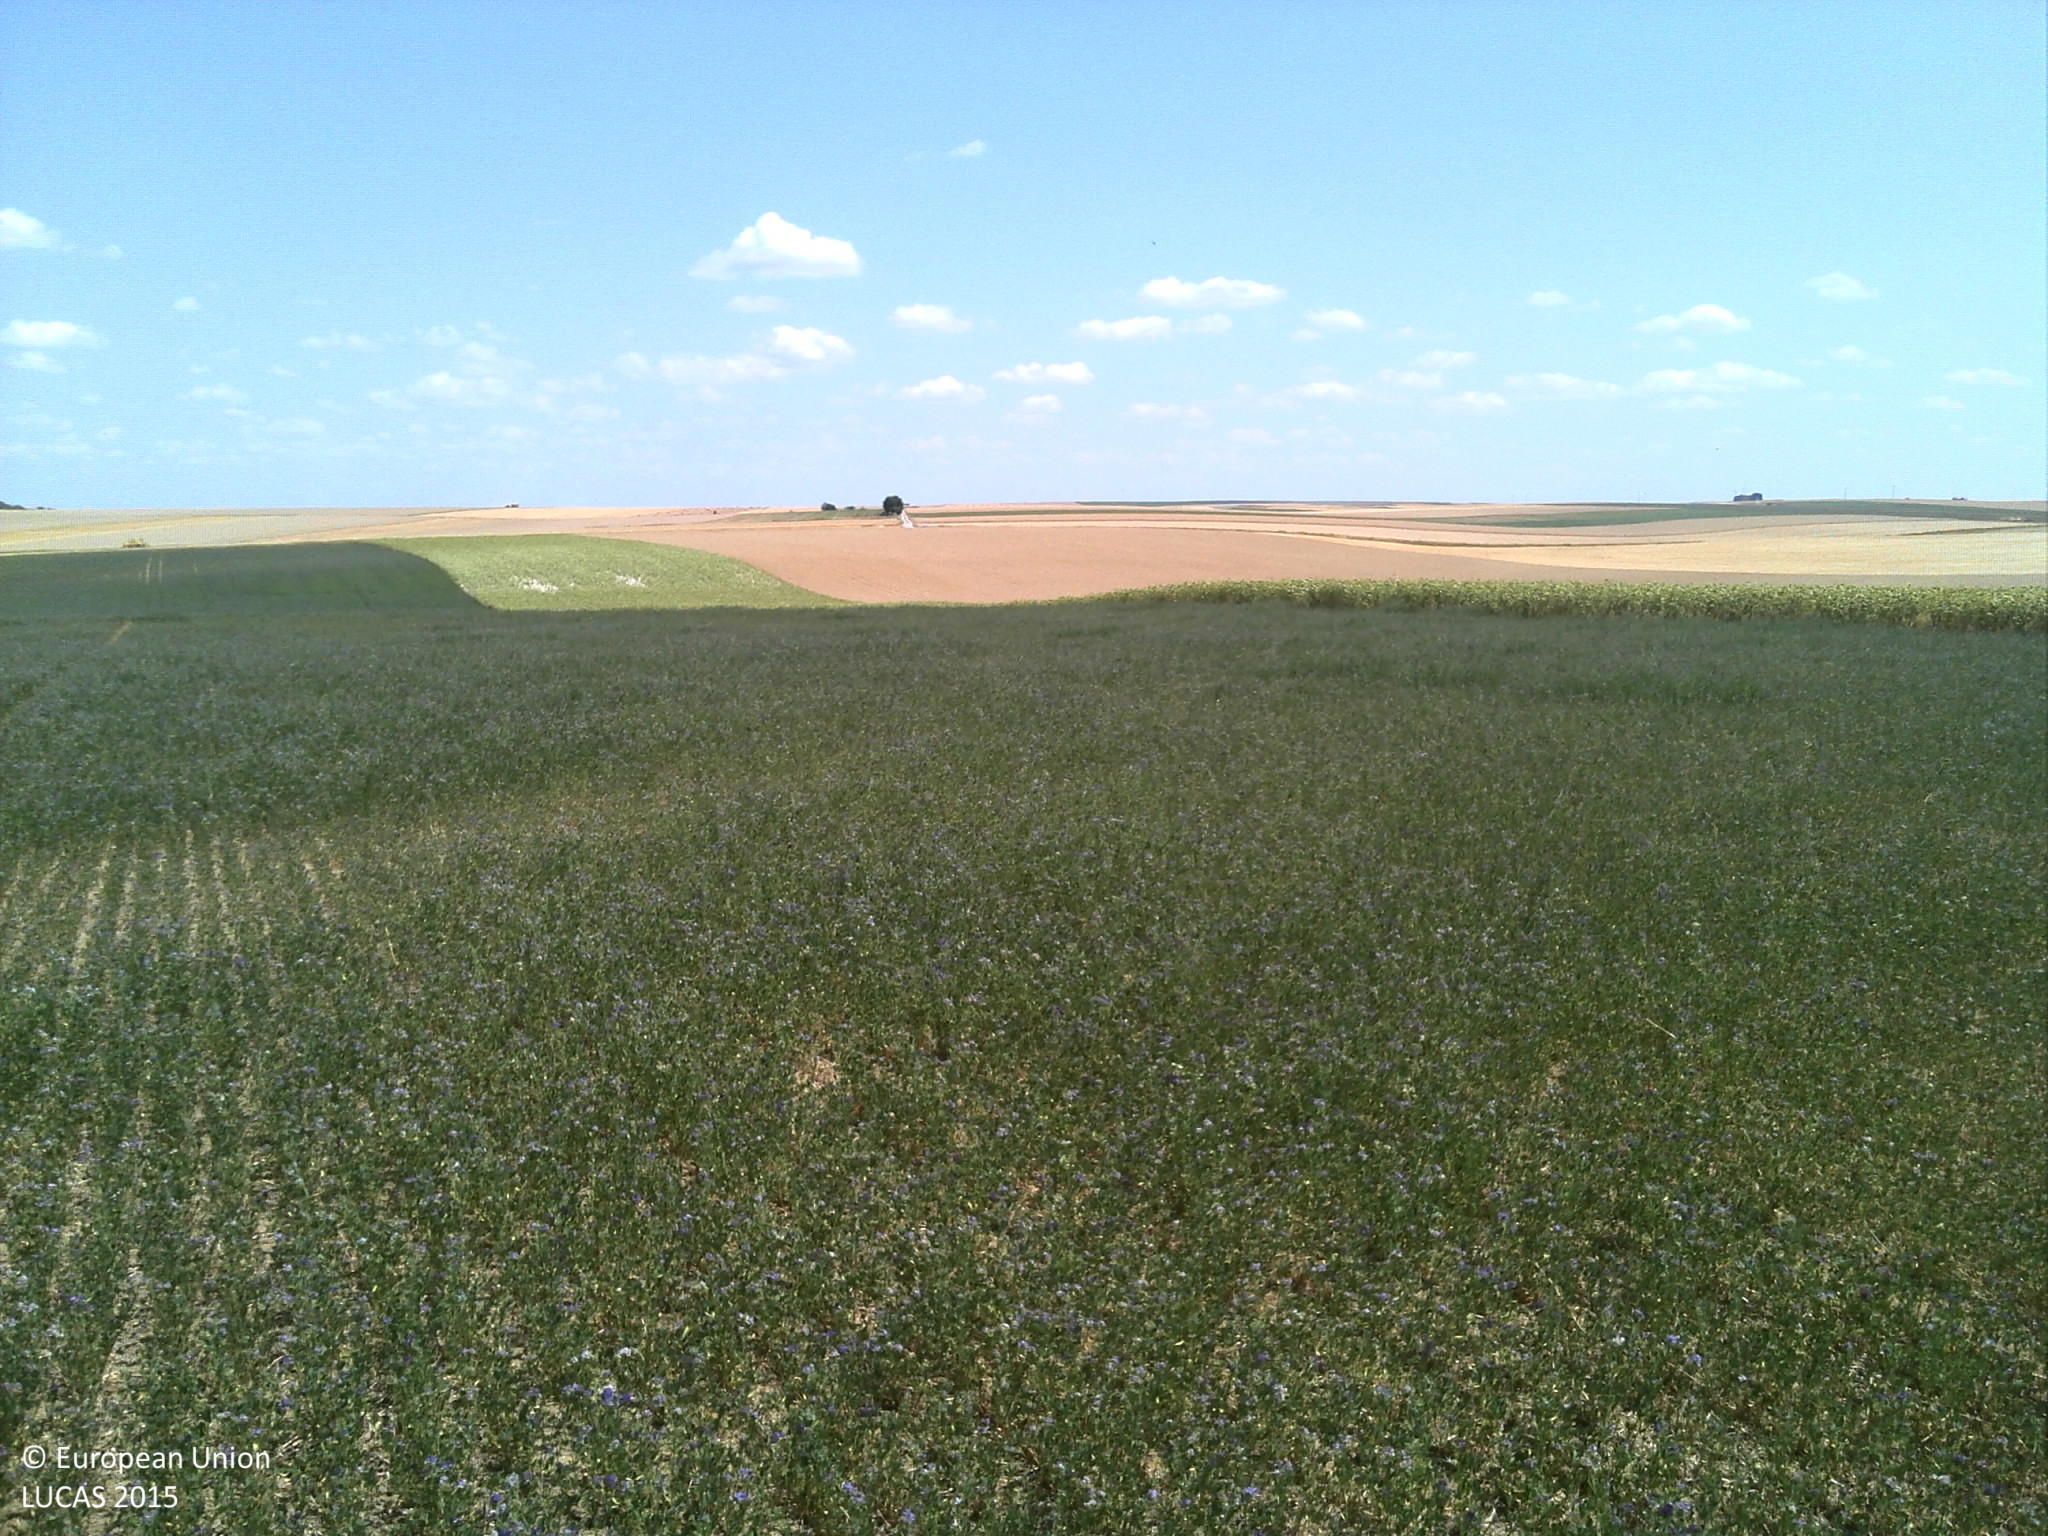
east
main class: Cropland
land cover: Lucerne
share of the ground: > 75 %
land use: Agriculture (excluding fallow land and kitchen gardens)
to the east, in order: Lucerne; Permanent industrial crops; Common wheat
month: July
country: FR
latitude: 49.4561
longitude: 4.1320
